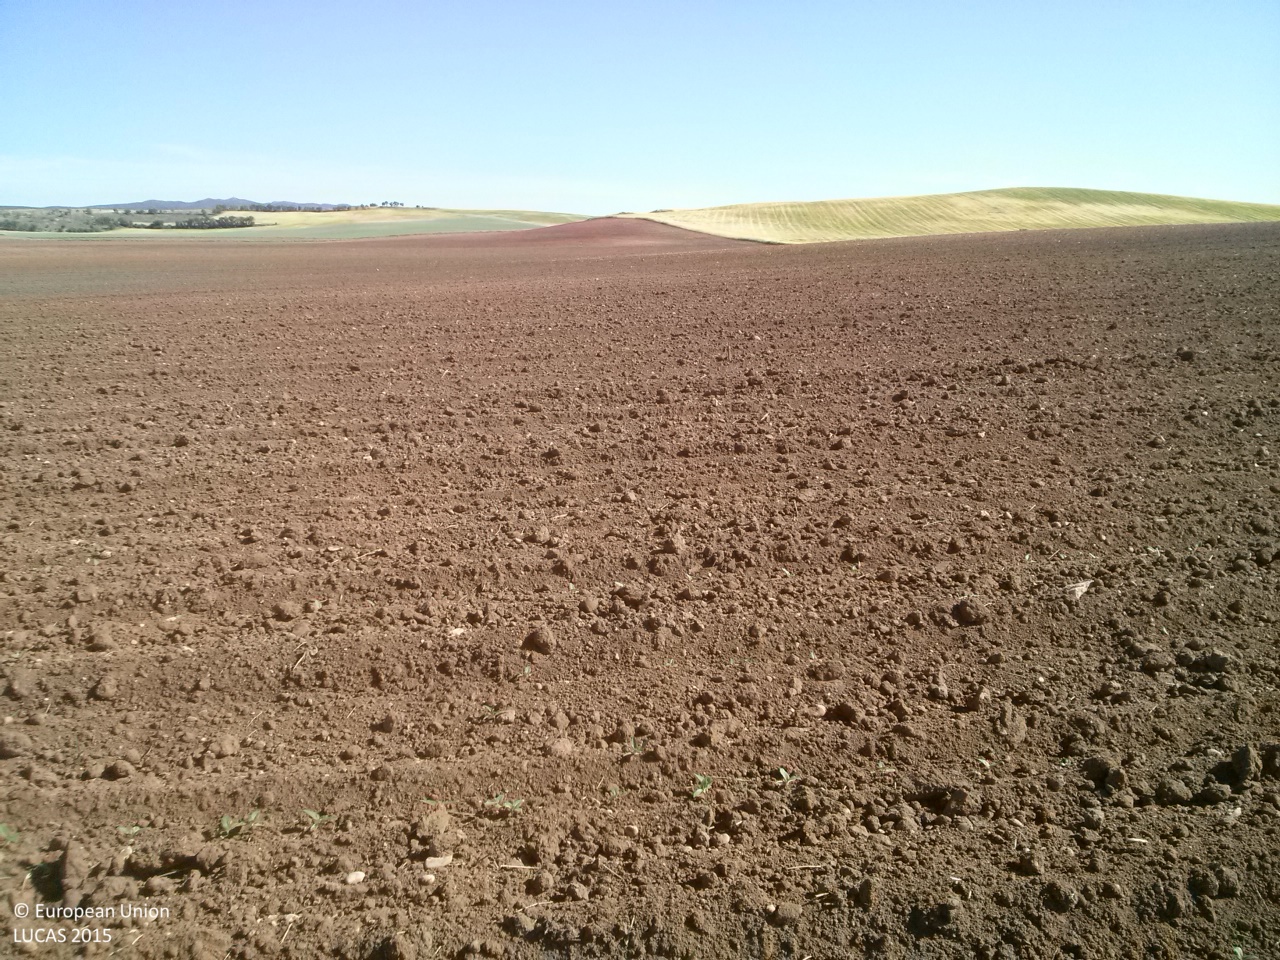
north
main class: Cropland
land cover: Sunflower
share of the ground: < 10 %
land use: Agriculture (excluding fallow land and kitchen gardens)
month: May
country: ES
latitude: 40.0280
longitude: -2.8062
